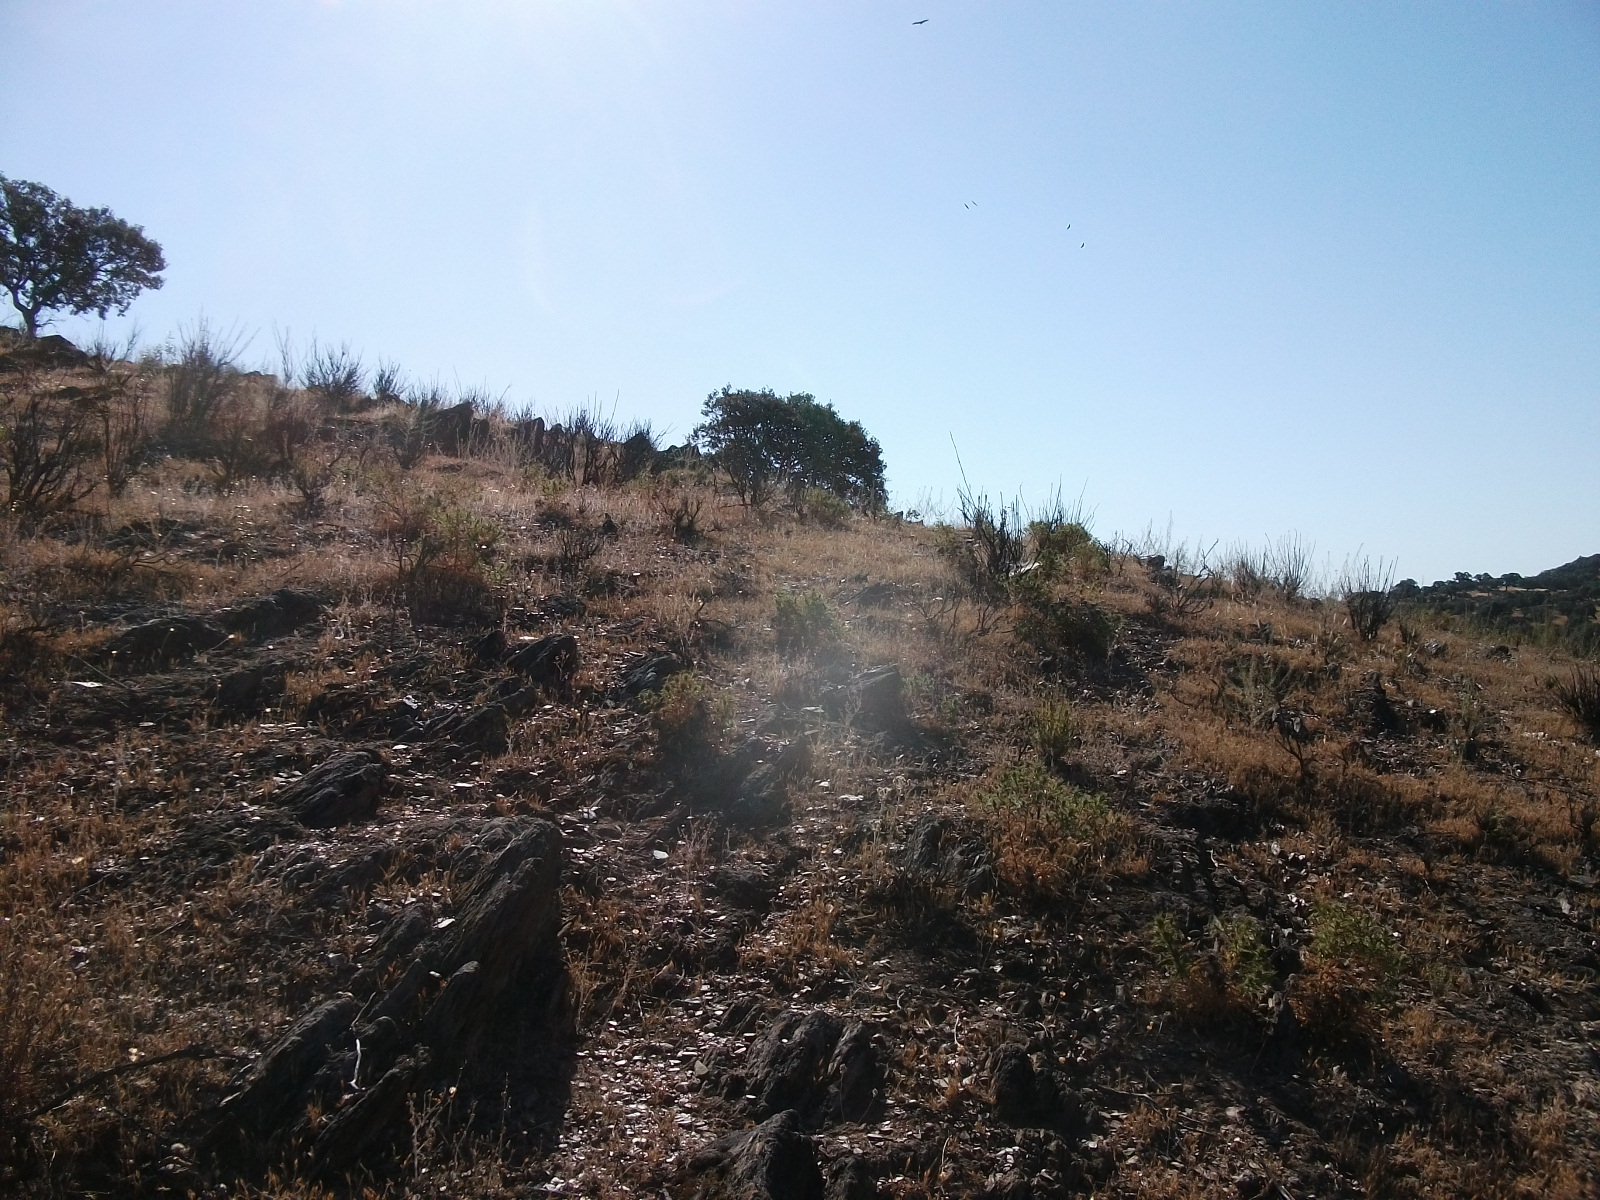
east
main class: Grassland
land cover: Grassland with sparse tree/shrub cover
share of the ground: > 75 %
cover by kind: herbaceous plants 95 %, broadleaved forest trees 5 %
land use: Agriculture (excluding fallow land and kitchen gardens)
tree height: < 5 m
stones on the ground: > 50 %
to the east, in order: Grassland with sparse tree/shrub cover; Fences; Shrubland without tree cover; Broadleaved woodland; Shrubland without tree cover
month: June
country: ES
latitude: 37.6392
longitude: -7.0352
